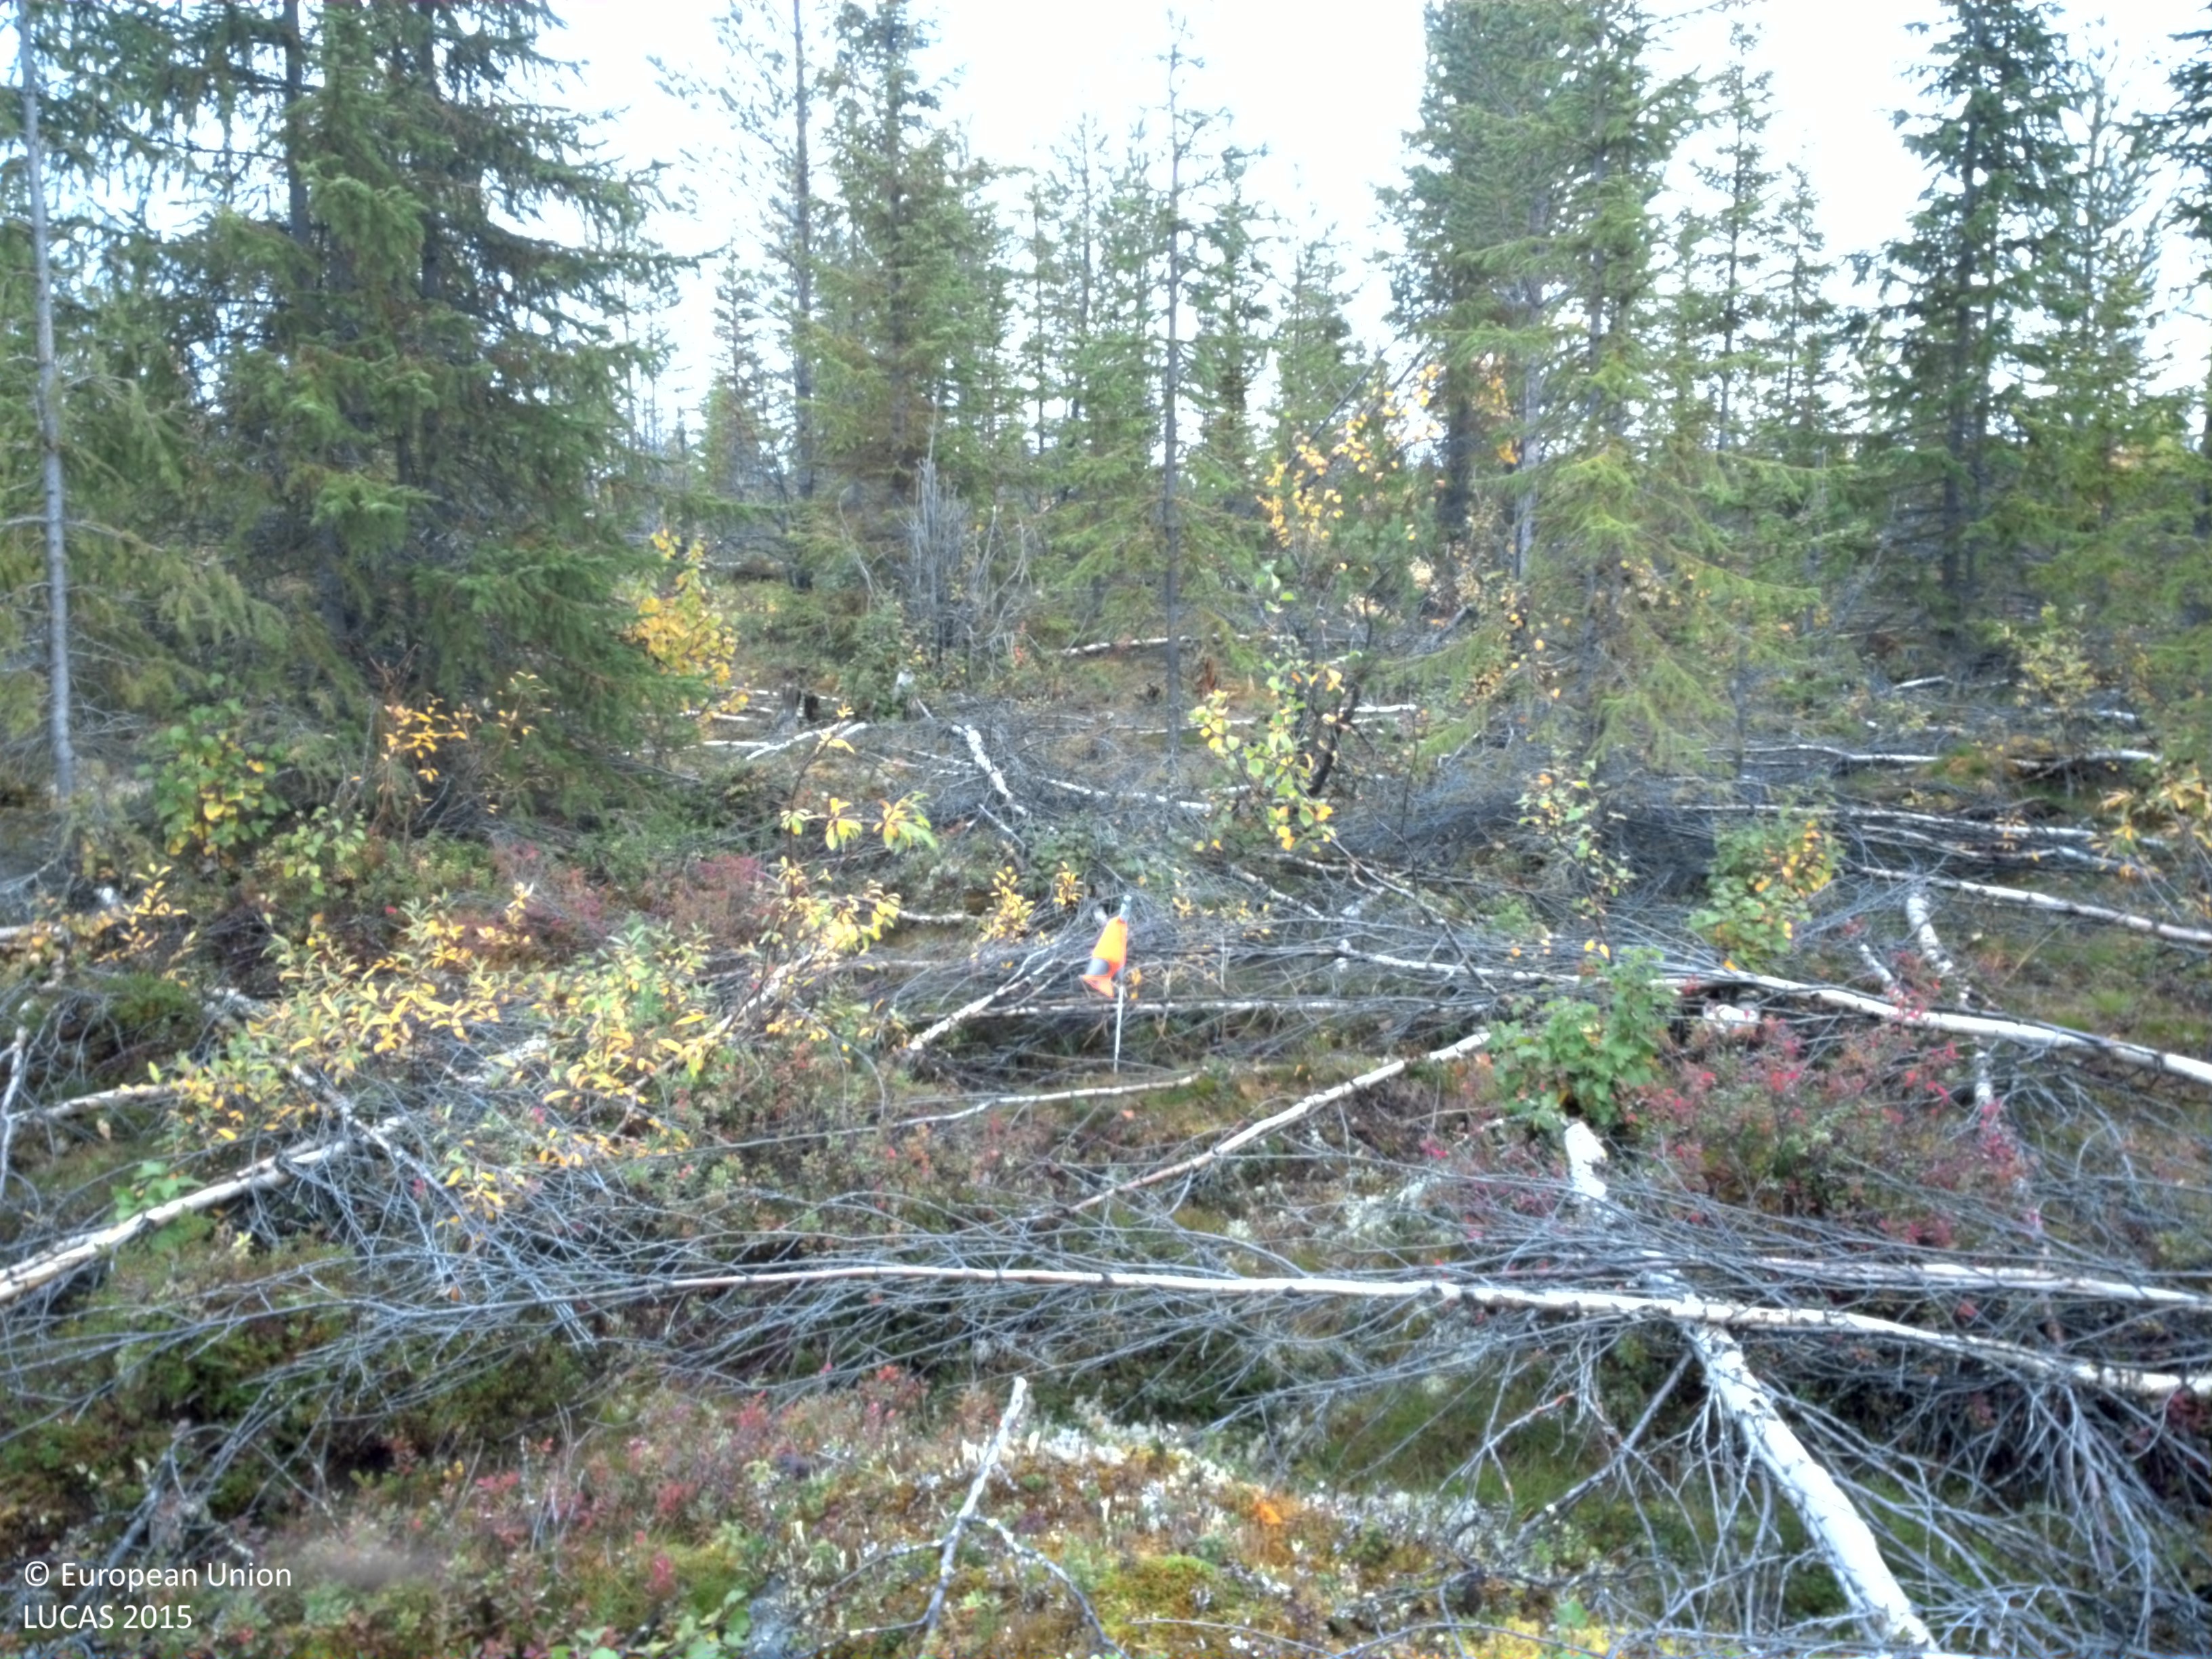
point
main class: Woodland
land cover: Spruce dominated coniferous woodland
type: boreal forest
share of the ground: 10 - 25 %
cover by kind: shrubs 40 %, lichens and mosses 20 %, herbaceous plants 15 %, coniferous forest trees 10 %
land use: Forestry
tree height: > 5 m
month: September
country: SE
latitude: 65.4030
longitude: 16.1425
